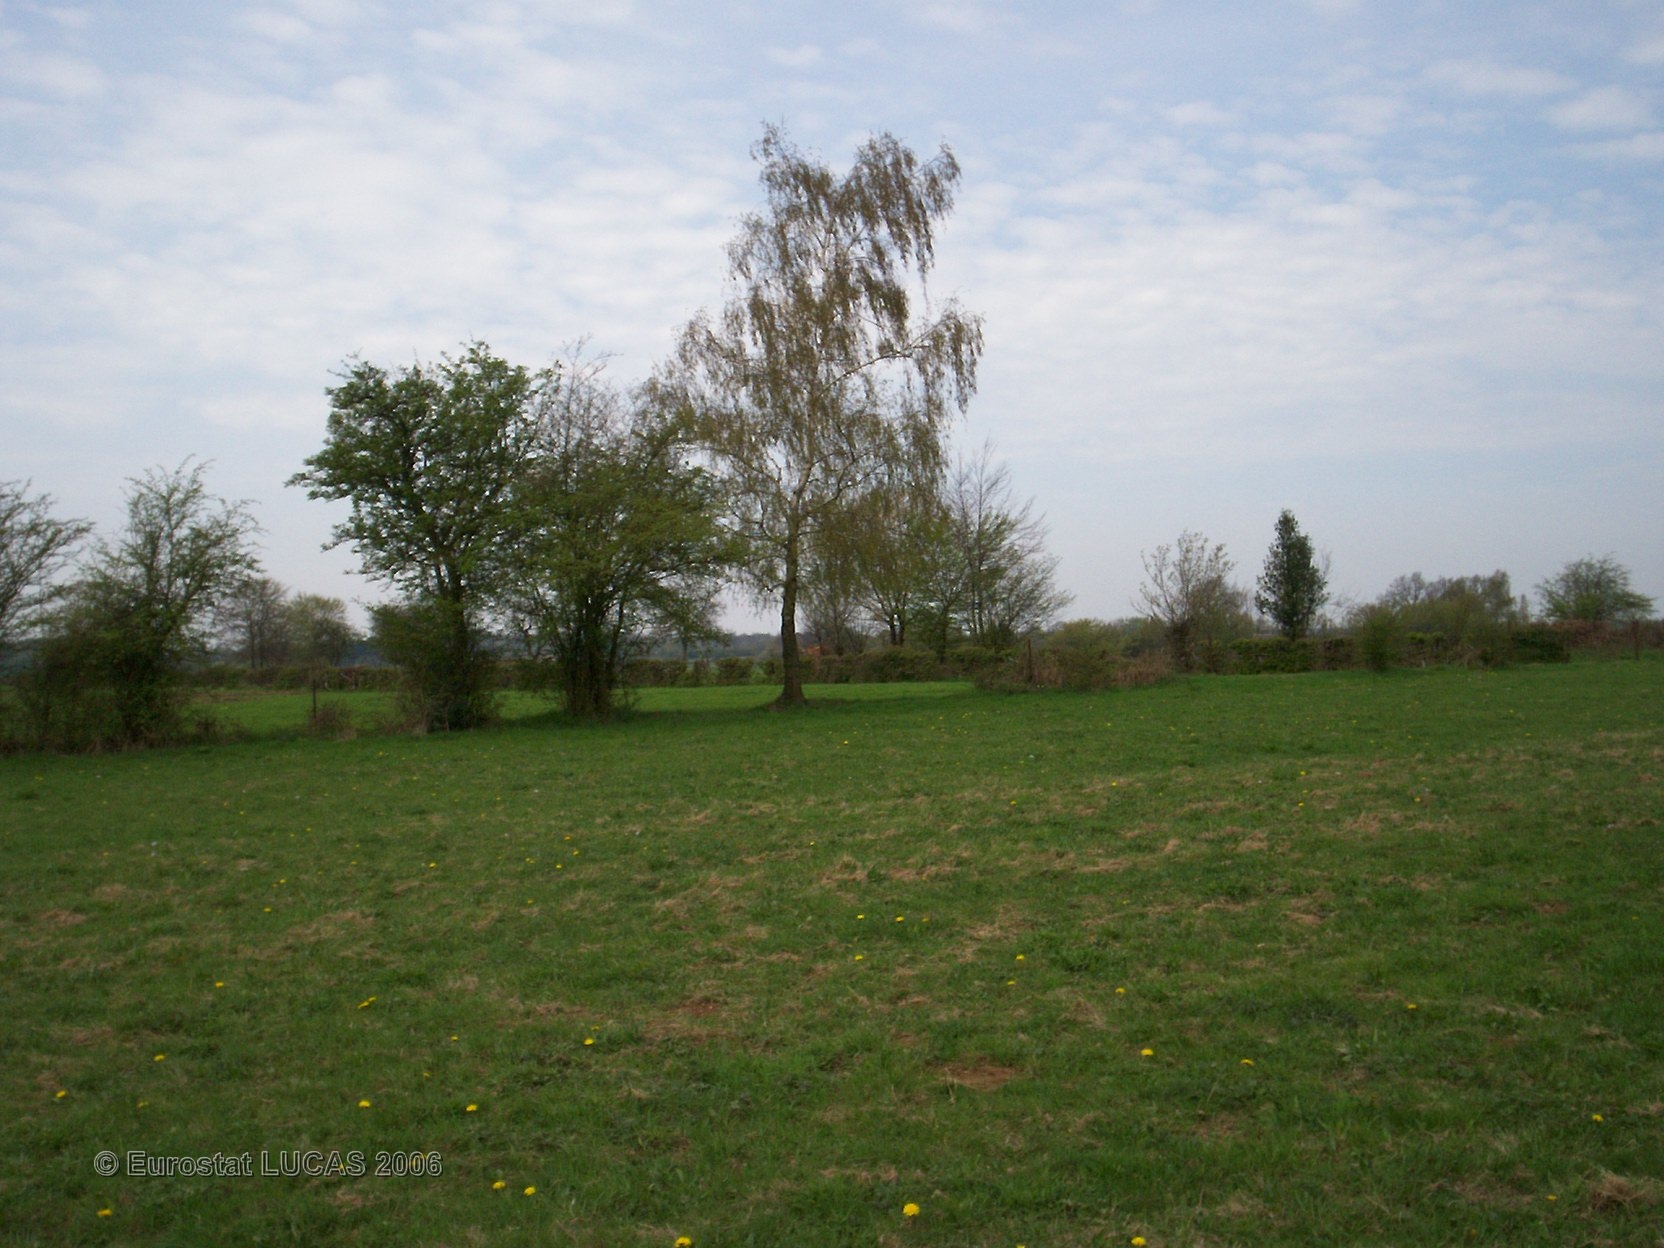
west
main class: Grassland
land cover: Grassland without tree/shrub cover
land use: Agriculture (excluding fallow land and kitchen gardens)
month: May
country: FR
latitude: 49.9334
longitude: 4.2973
